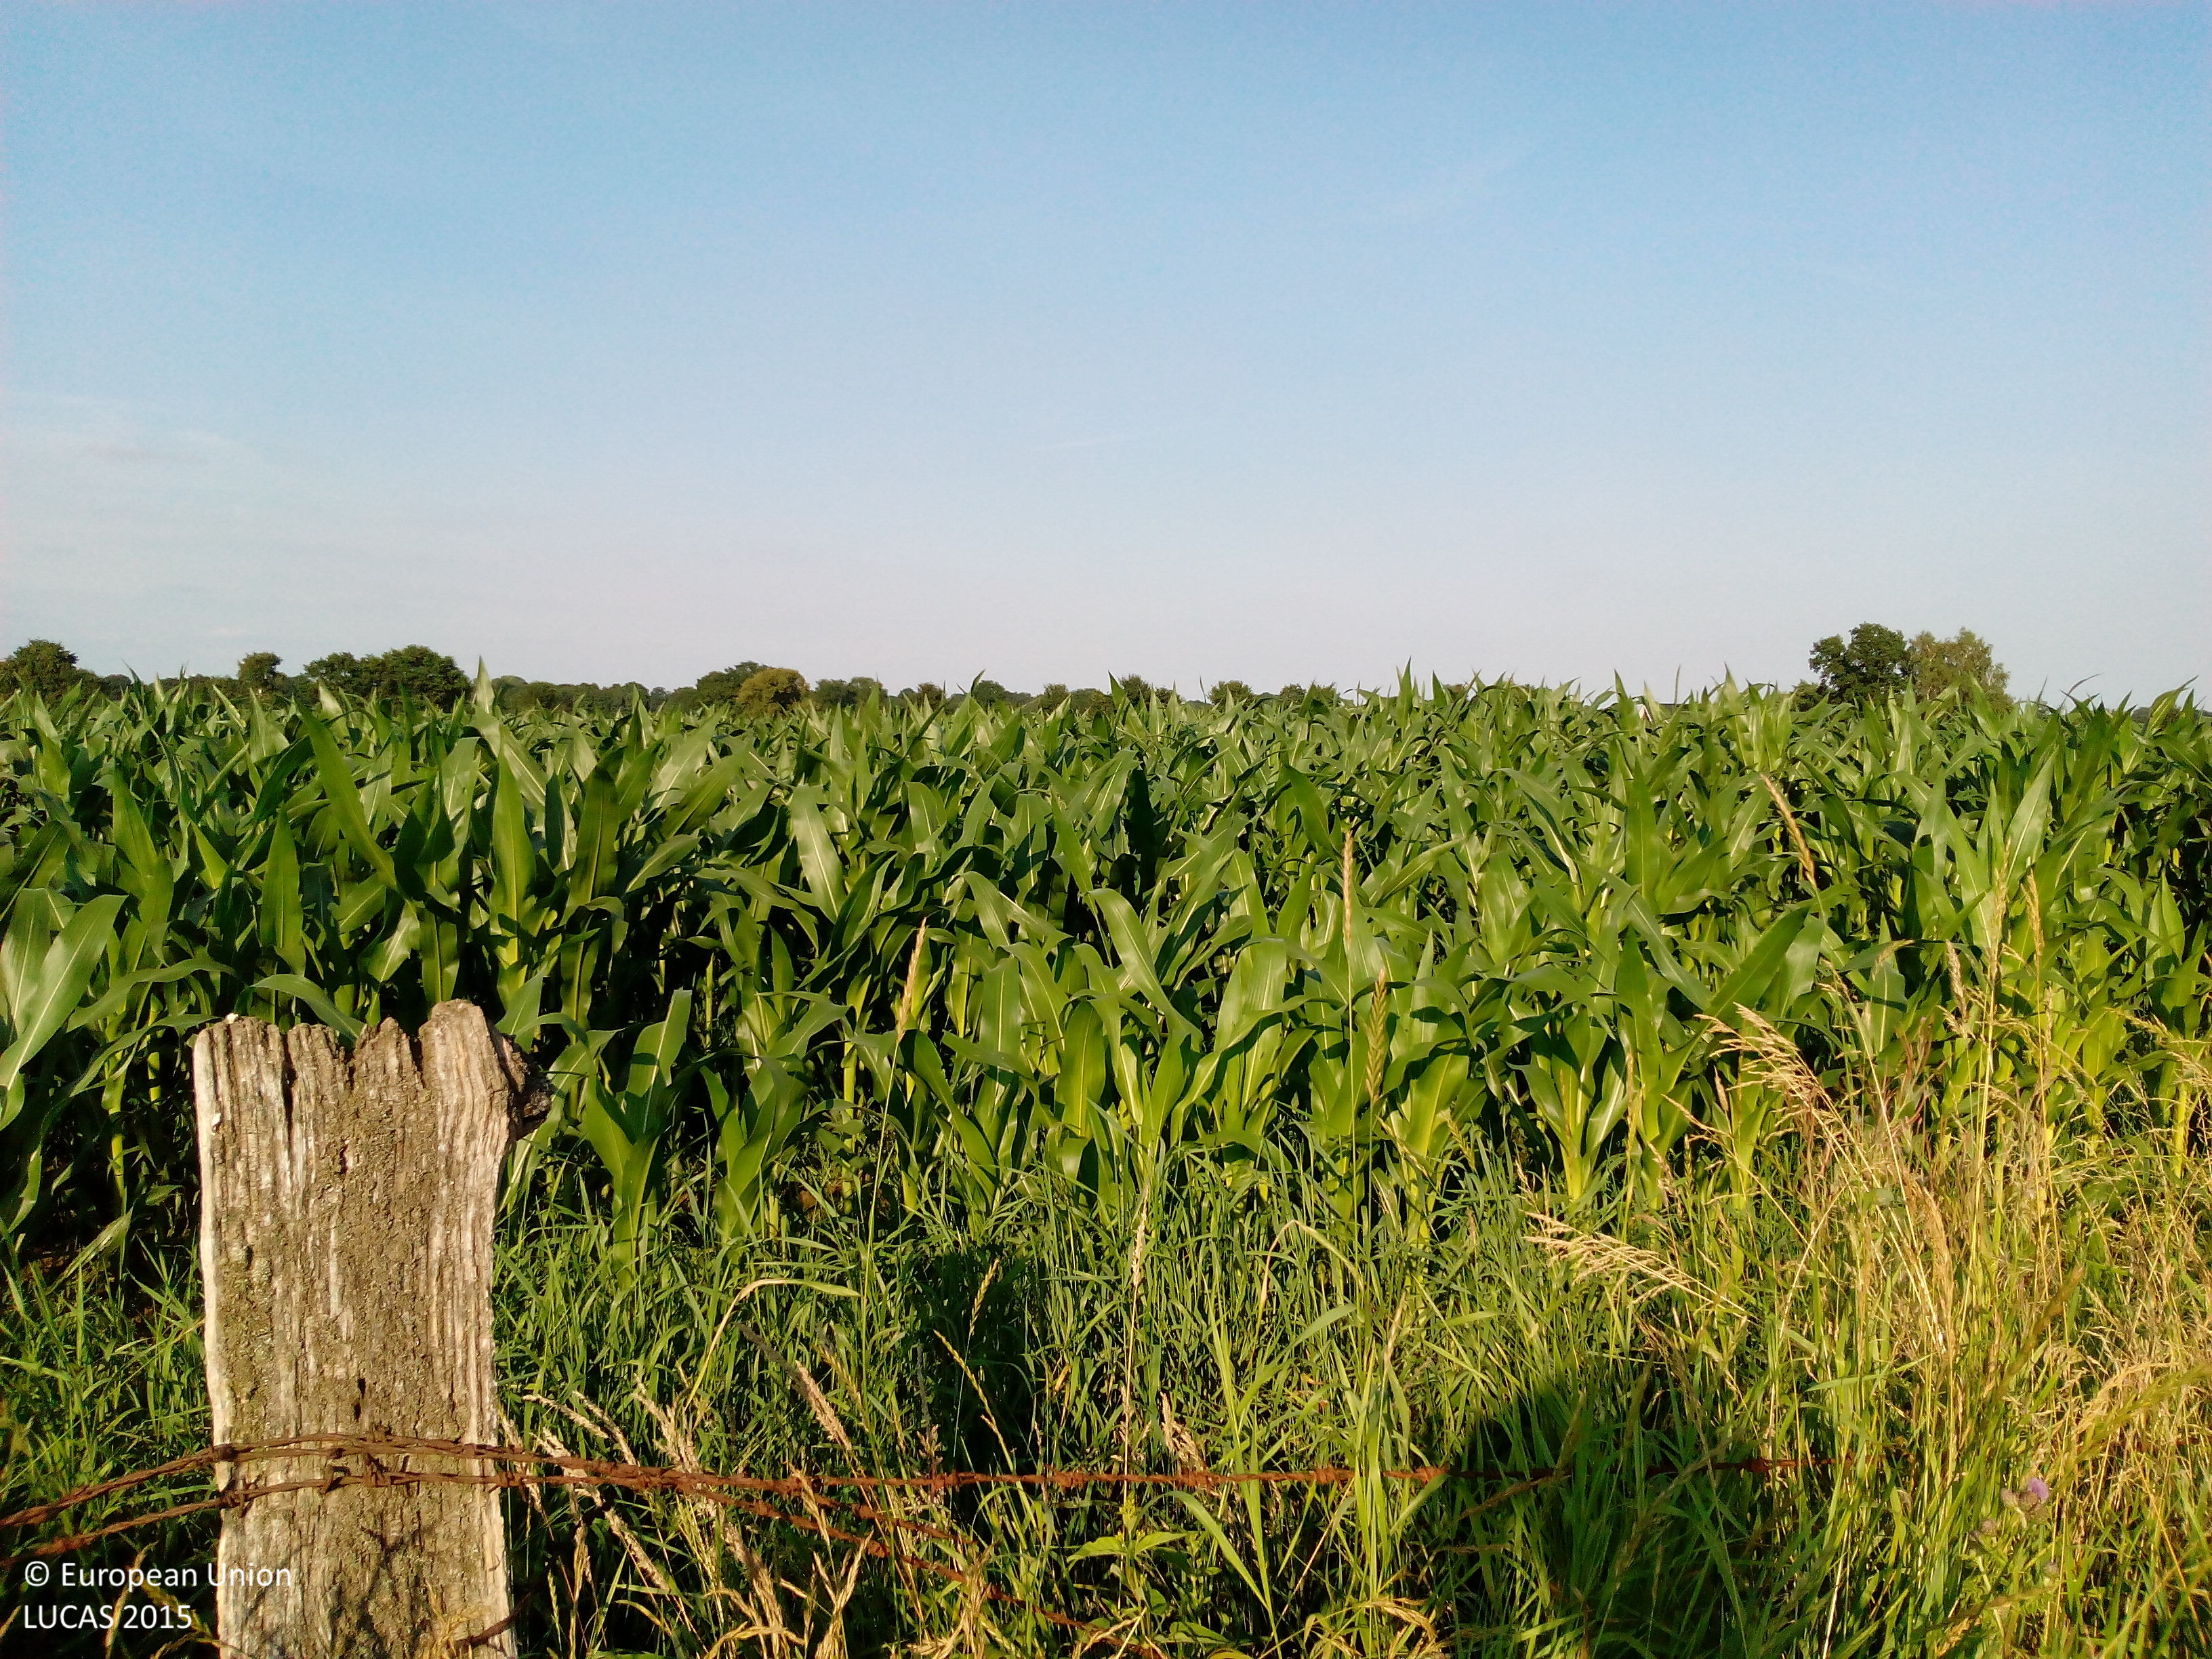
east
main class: Cropland
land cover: Maize
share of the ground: > 75 %
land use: Agriculture (excluding fallow land and kitchen gardens)
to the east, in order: Maize; Grass margins; Fences; Ditches and canals; Grassland without tree/shrub cover; Maize; Common wheat
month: July
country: DE
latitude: 52.5216
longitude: 7.9519
